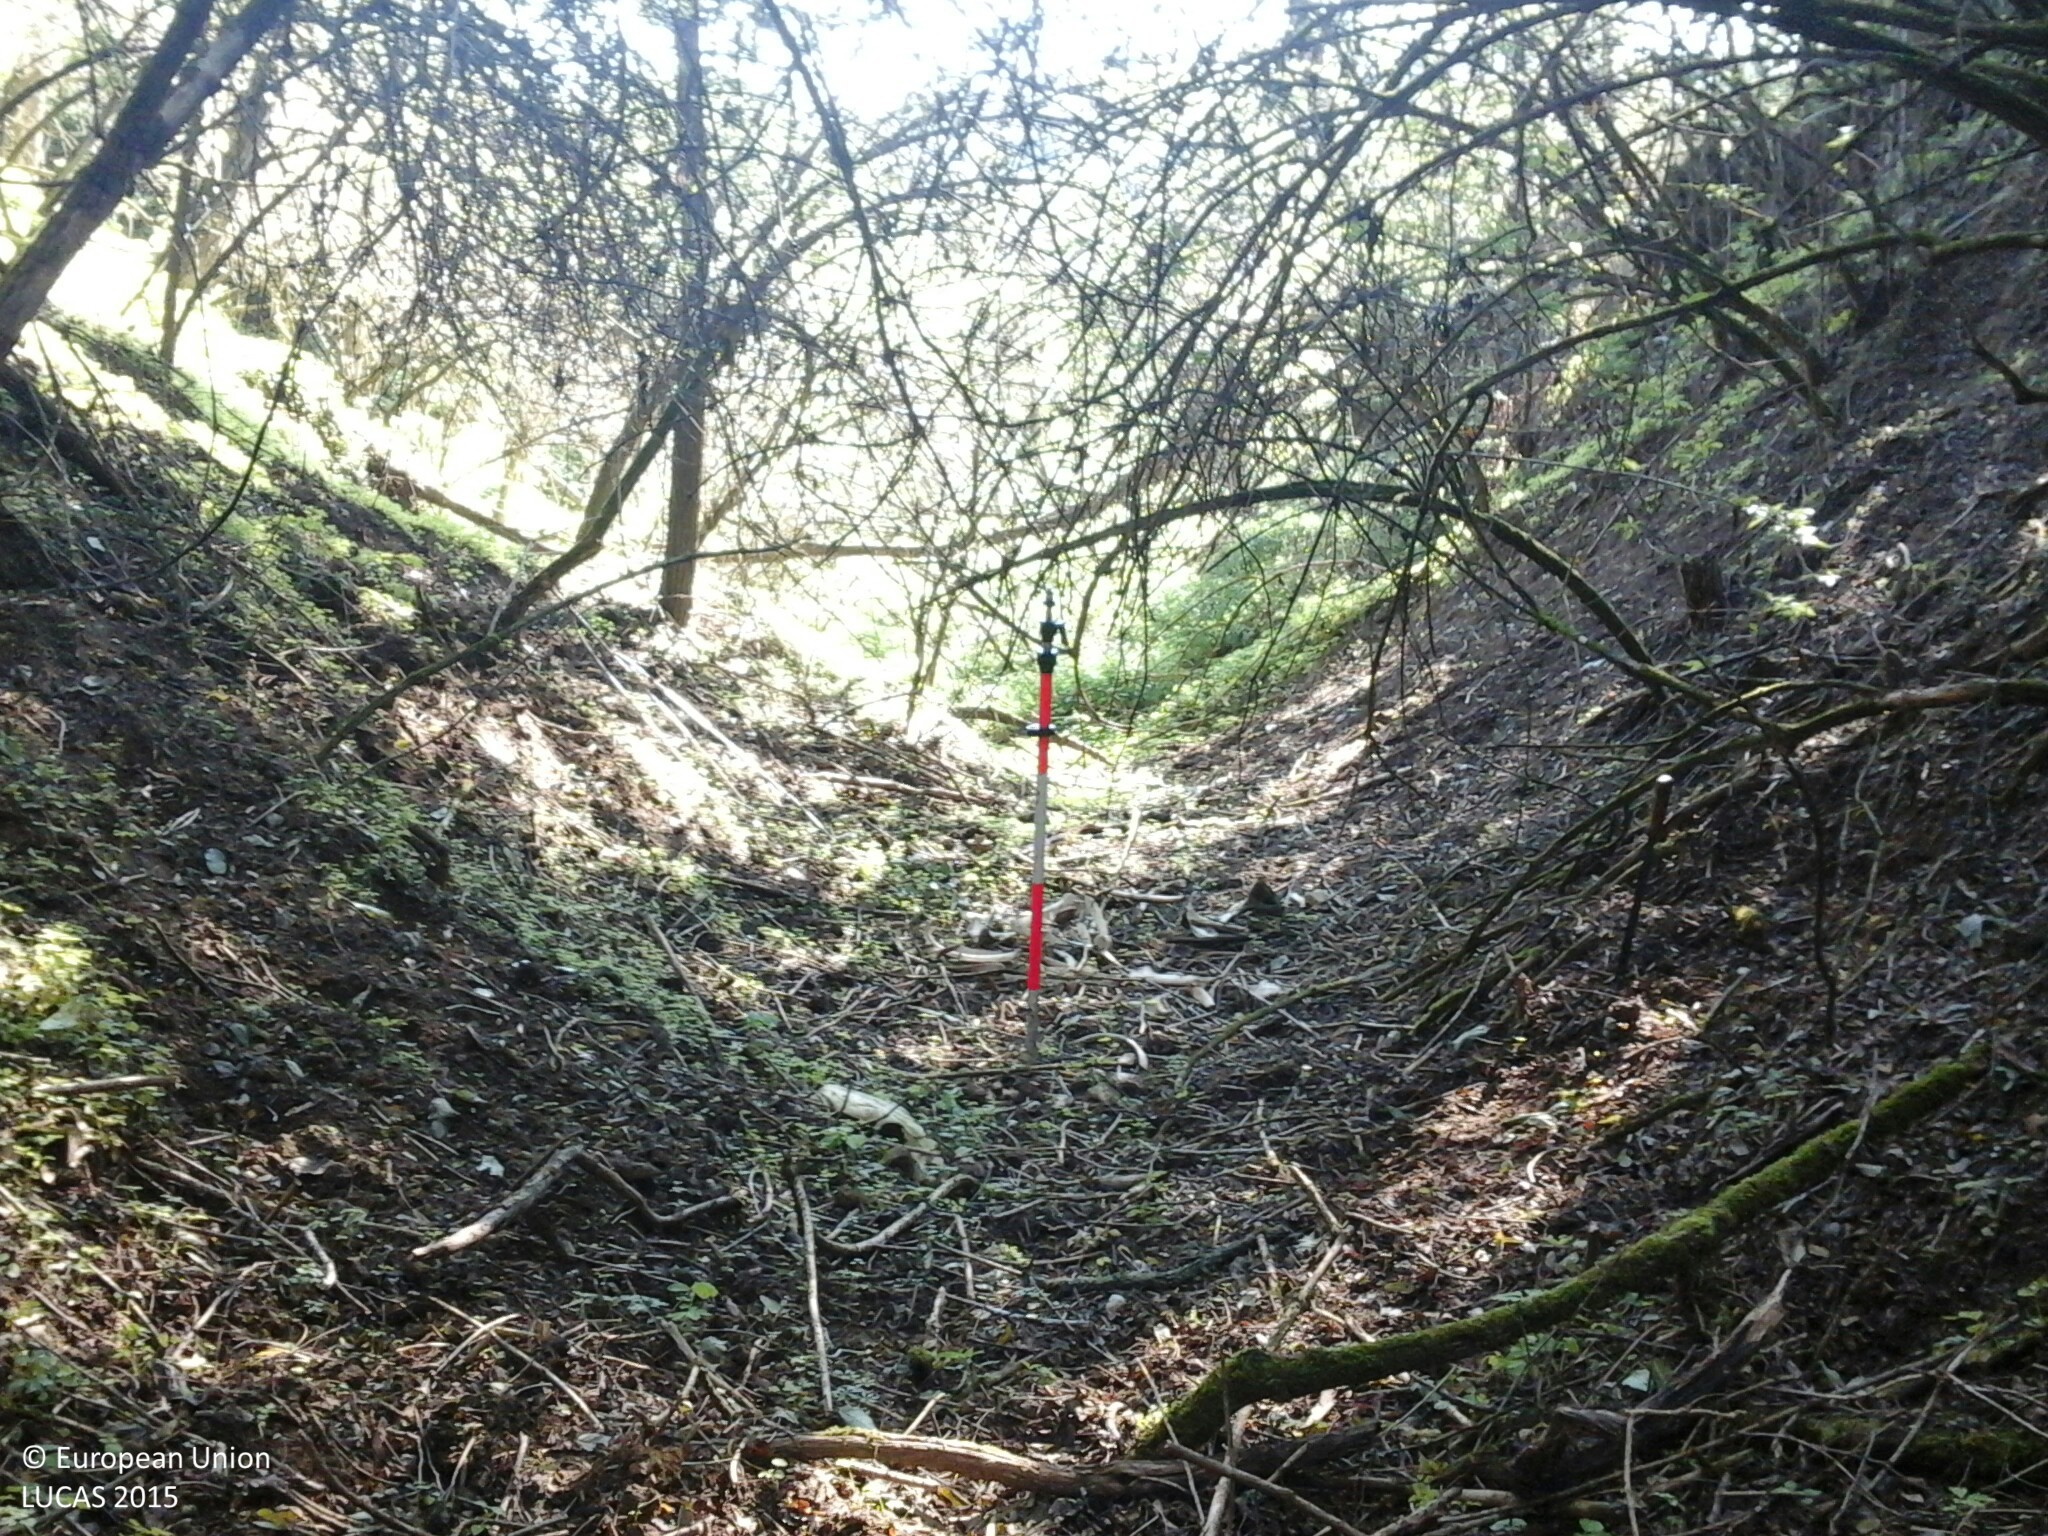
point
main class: Woodland
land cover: Broadleaved woodland
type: mesophytic deciduous forest
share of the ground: > 75 %
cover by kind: broadleaved forest trees 90 %, shrubs 5 %, herbaceous plants 5 %
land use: Forestry
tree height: > 5 m
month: September
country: HU
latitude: 48.1317
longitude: 19.9849
